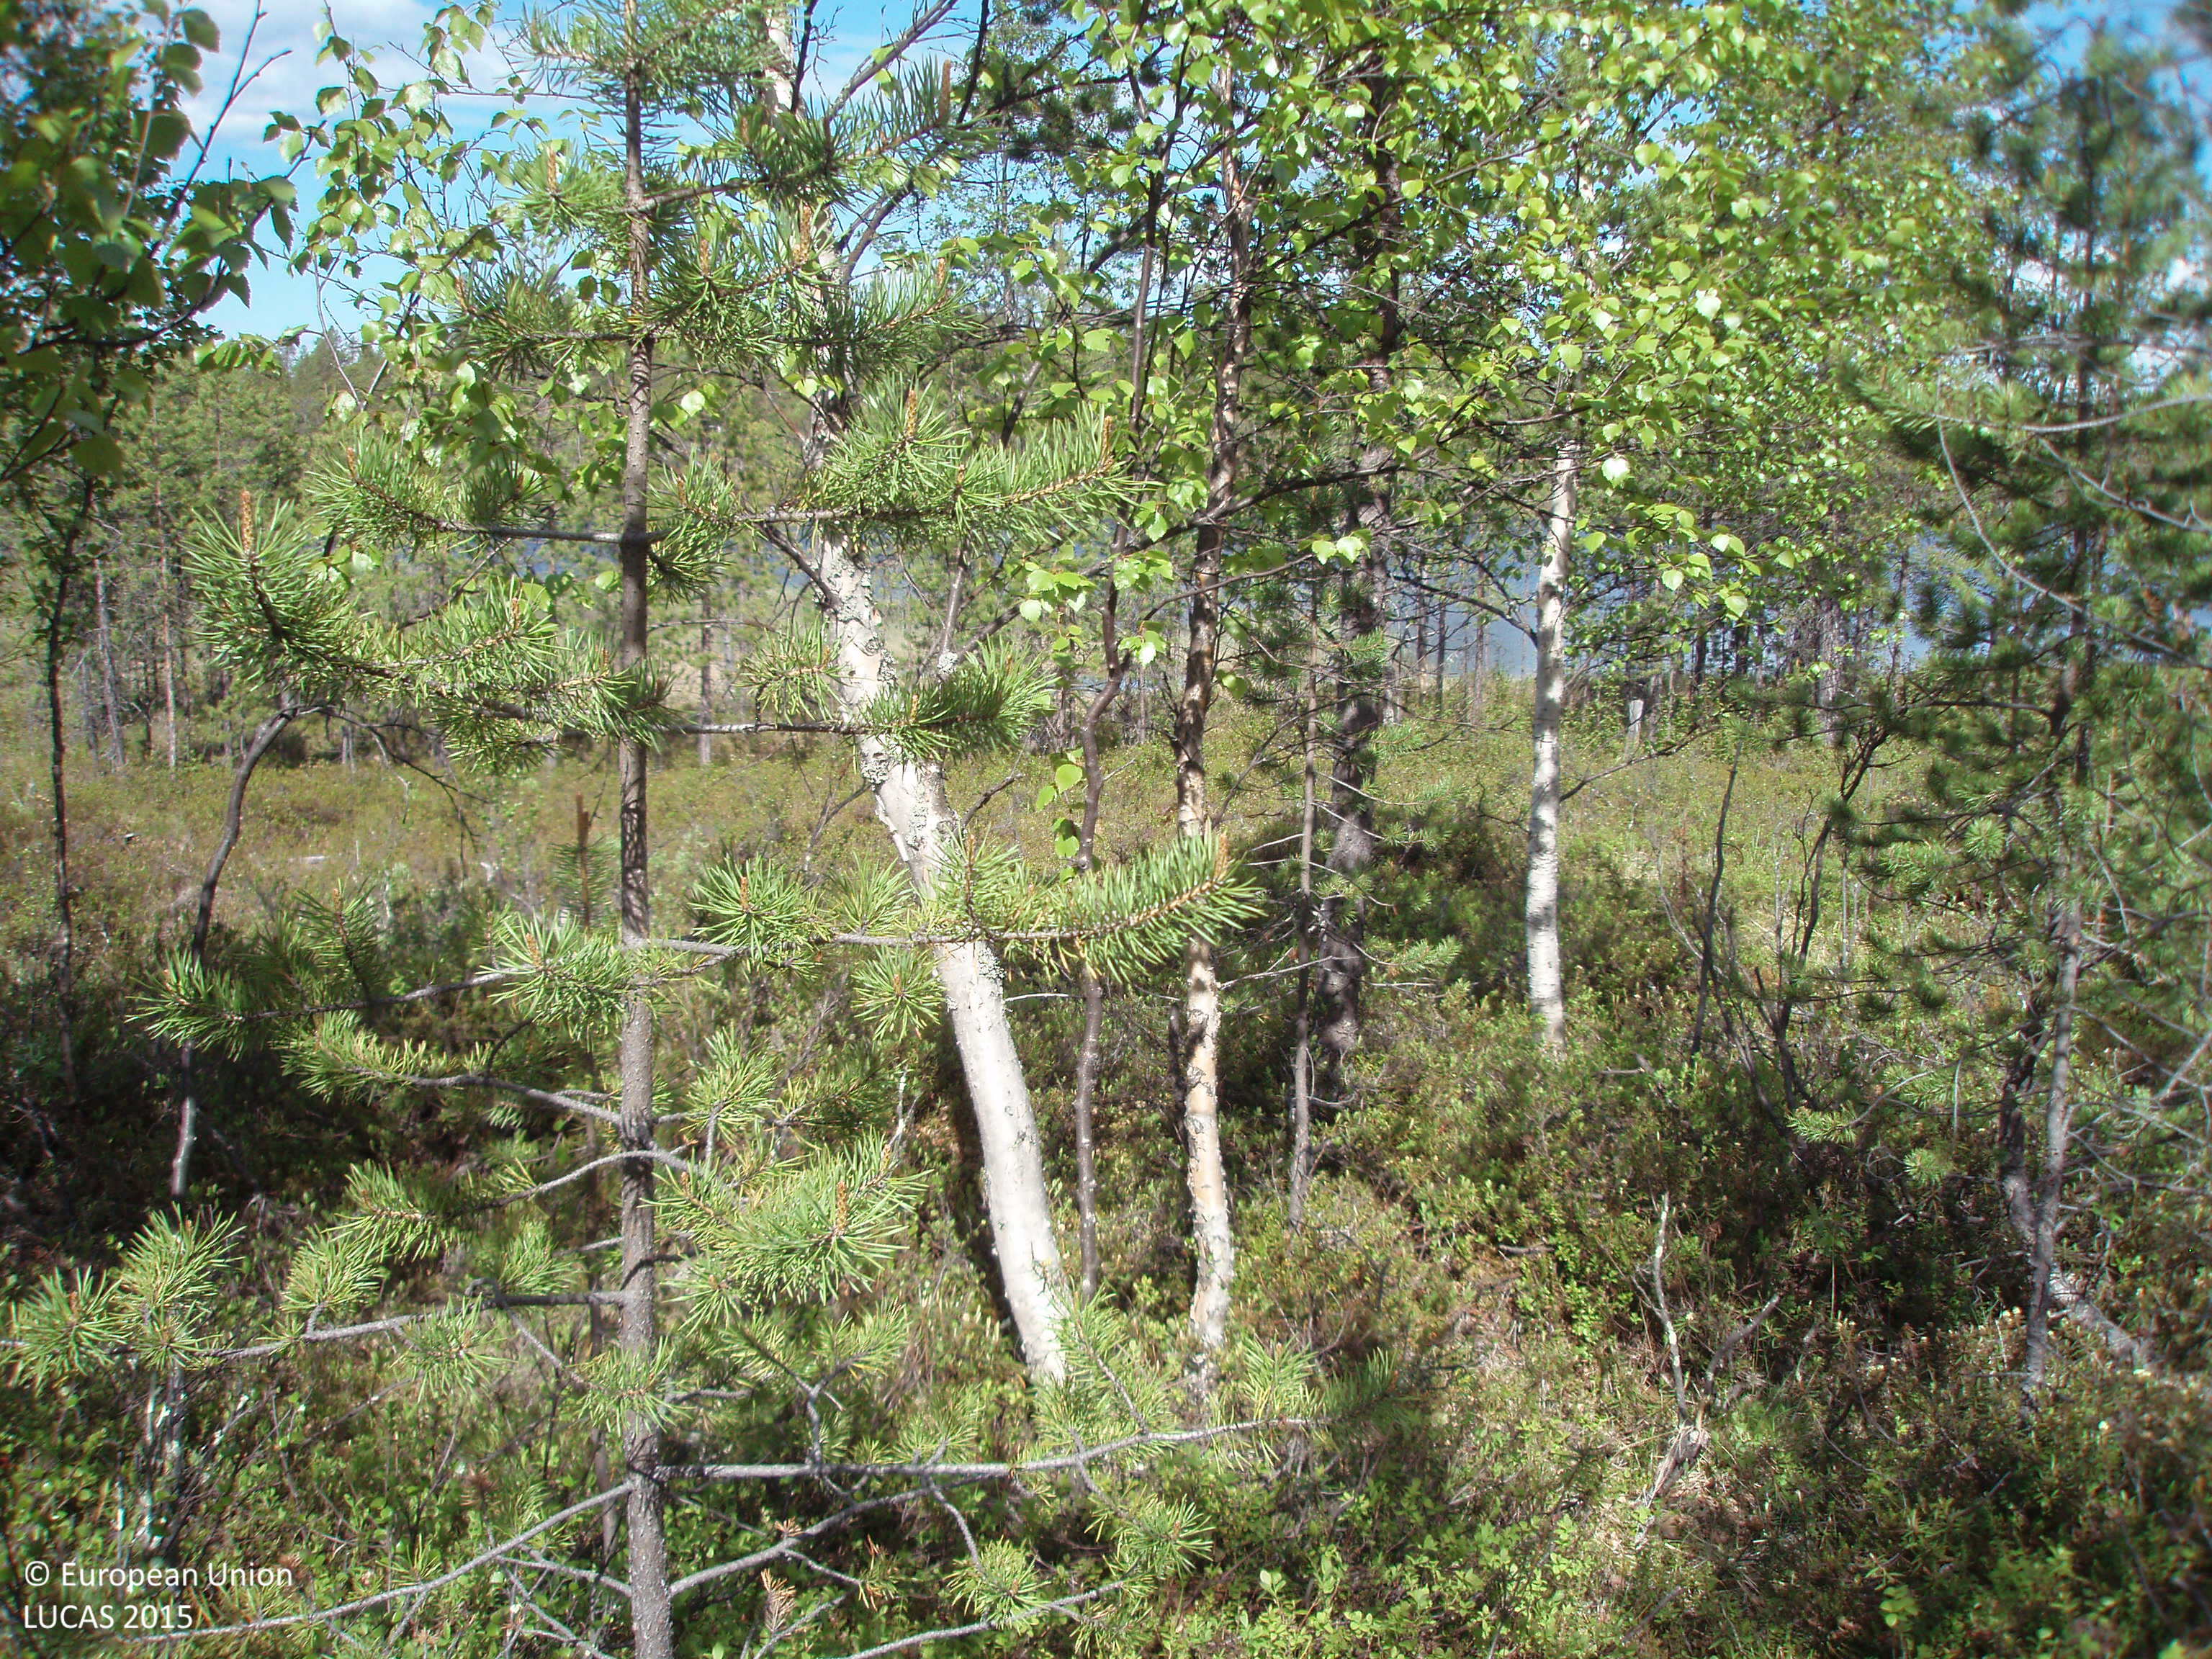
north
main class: Woodland
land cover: Pine dominated mixed woodland
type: boreal forest
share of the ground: 50 - 75 %
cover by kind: broadleaved forest trees 40 %, coniferous forest trees 30 %, shrubs 20 %, herbaceous plants 5 %, lichens and mosses 5 %
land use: Forestry
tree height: > 5 m
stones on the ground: 25 - 50 %
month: June
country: FI
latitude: 68.7707
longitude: 28.0821
